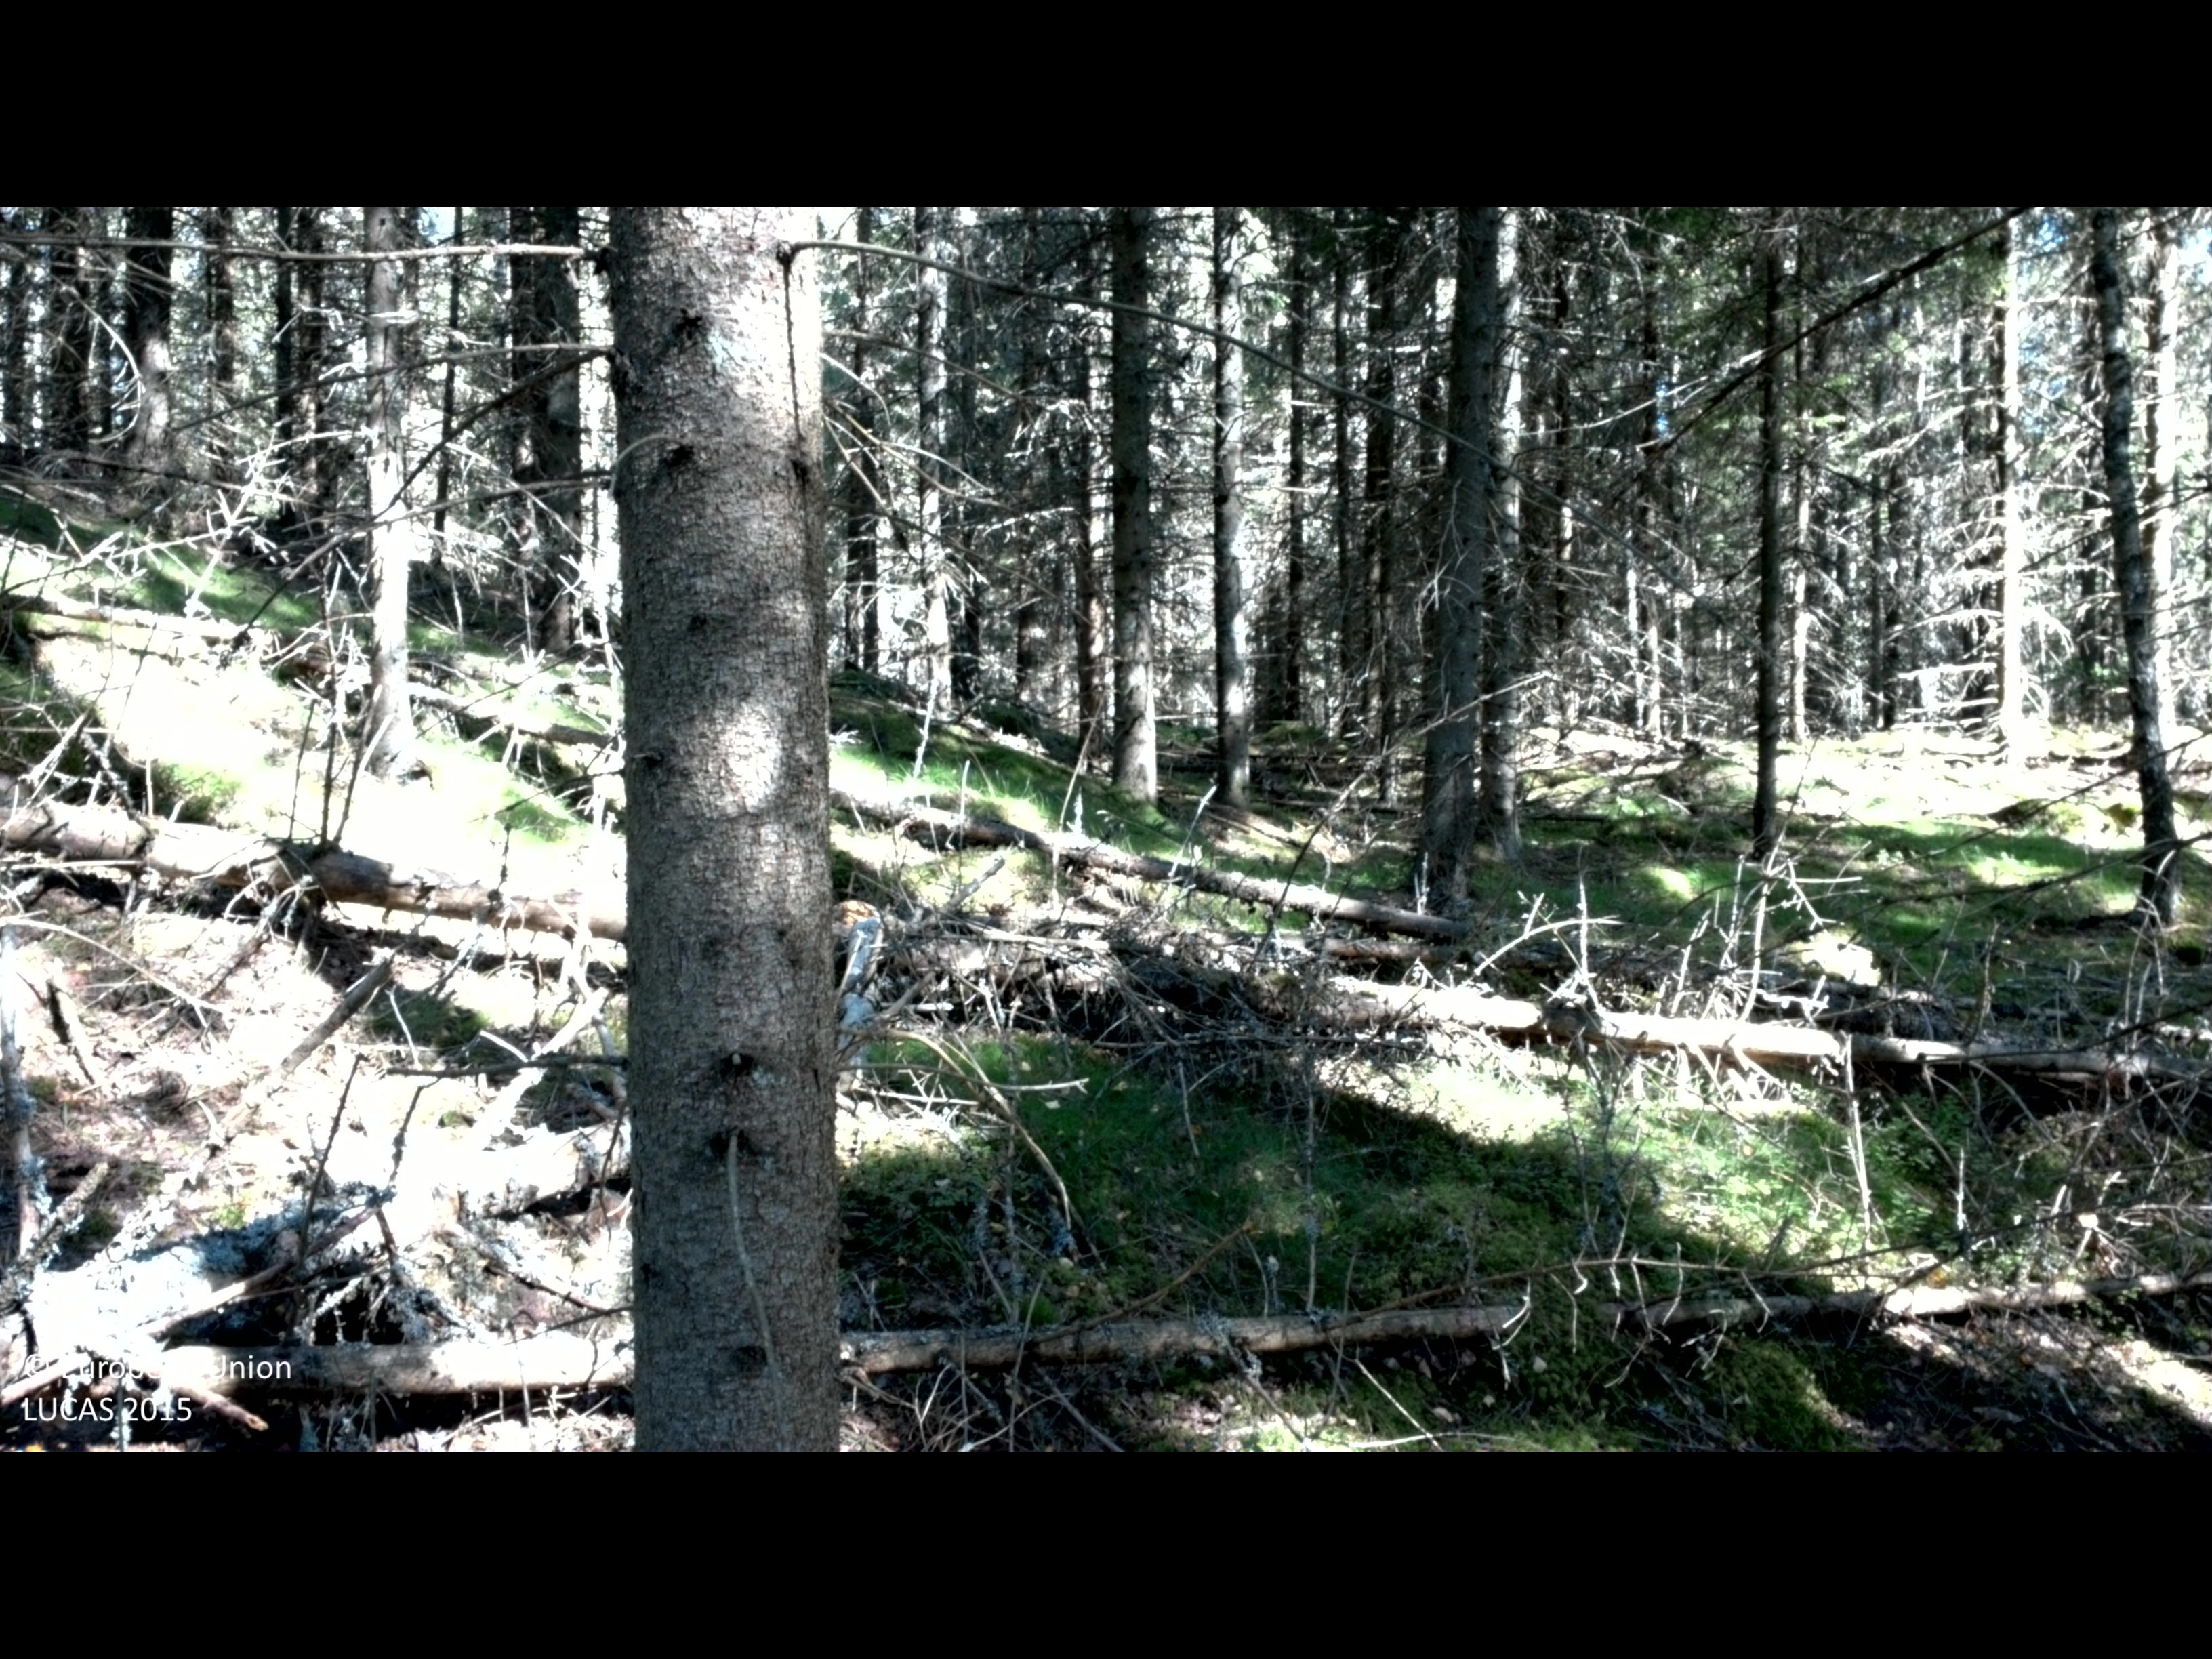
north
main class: Woodland
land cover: Spruce dominated mixed woodland
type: boreal forest
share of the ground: > 75 %
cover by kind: coniferous forest trees 50 %, broadleaved forest trees 25 %, shrubs 15 %, lichens and mosses 10 %
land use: Forestry
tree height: > 5 m
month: August
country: SE
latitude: 57.0116
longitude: 13.8662
